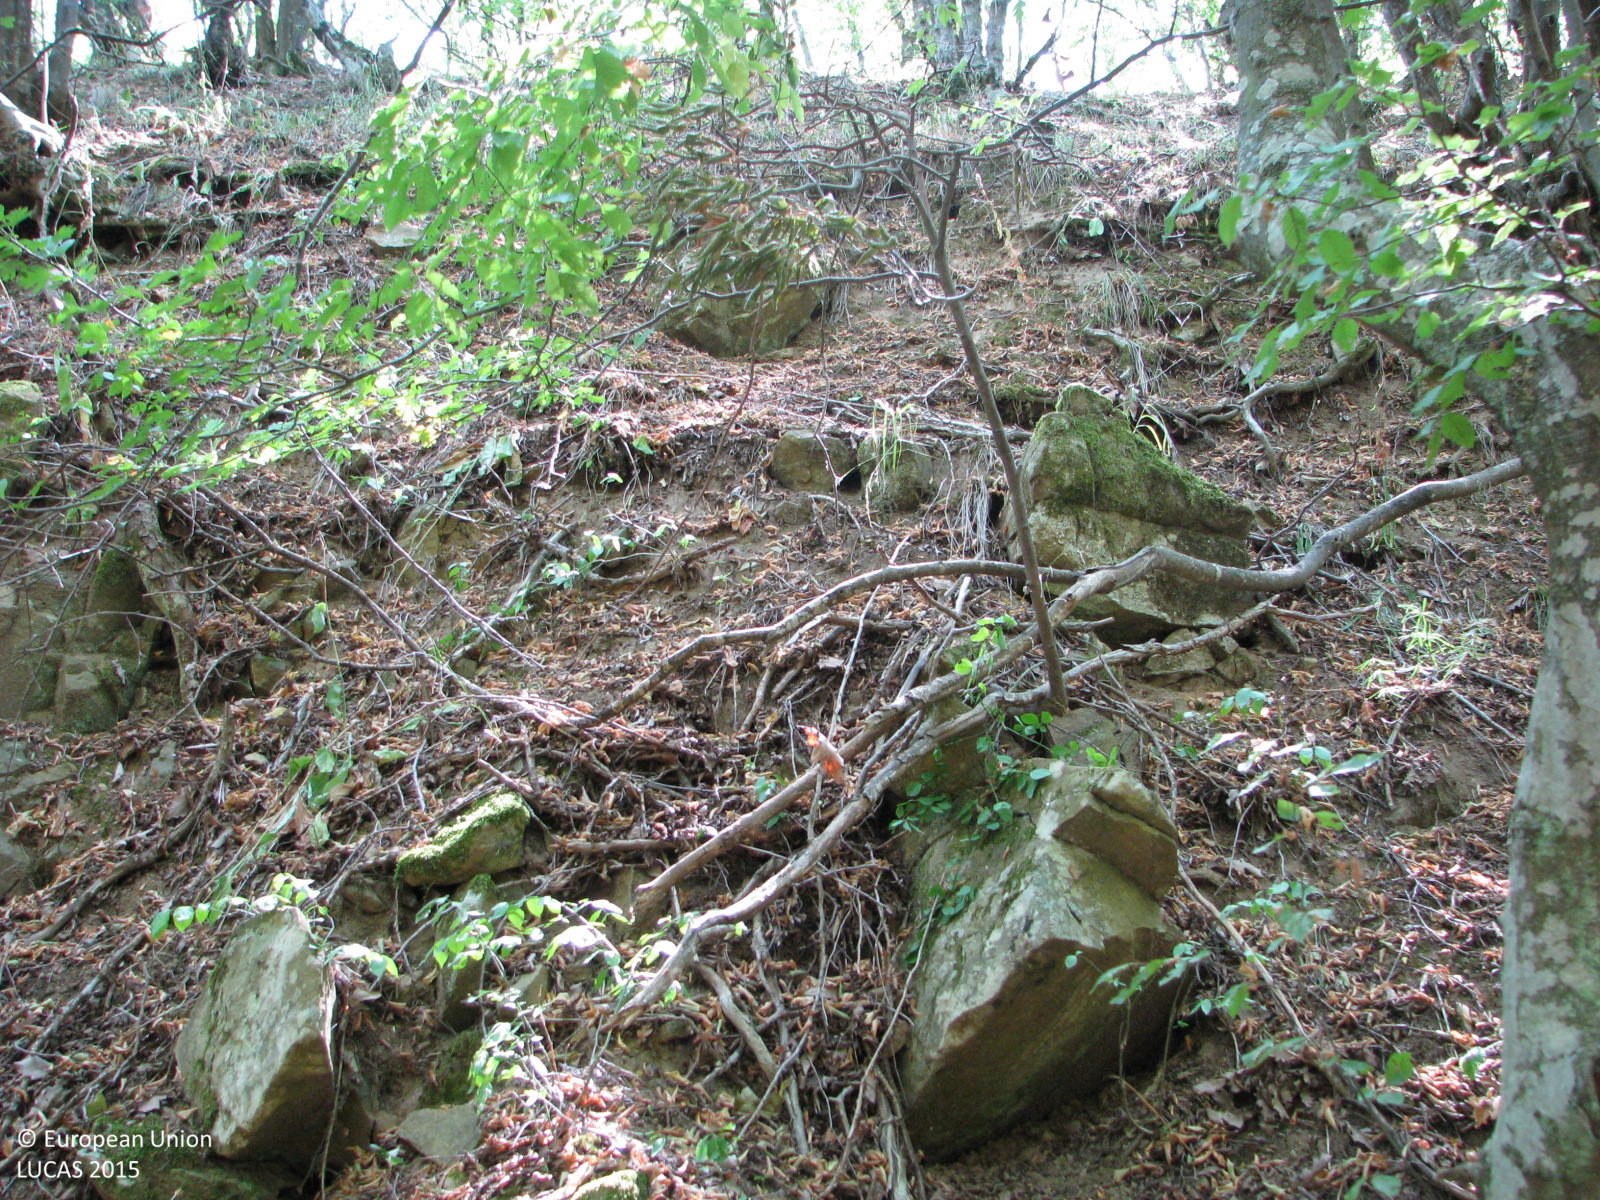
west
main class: Woodland
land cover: Broadleaved woodland
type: beech forest
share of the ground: 50 - 75 %
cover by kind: broadleaved forest trees 65 %, unconsolidated bare surface 25 %, herbaceous plants 10 %
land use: Forestry
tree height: > 5 m
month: August
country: BG
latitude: 42.7540
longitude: 26.6548
